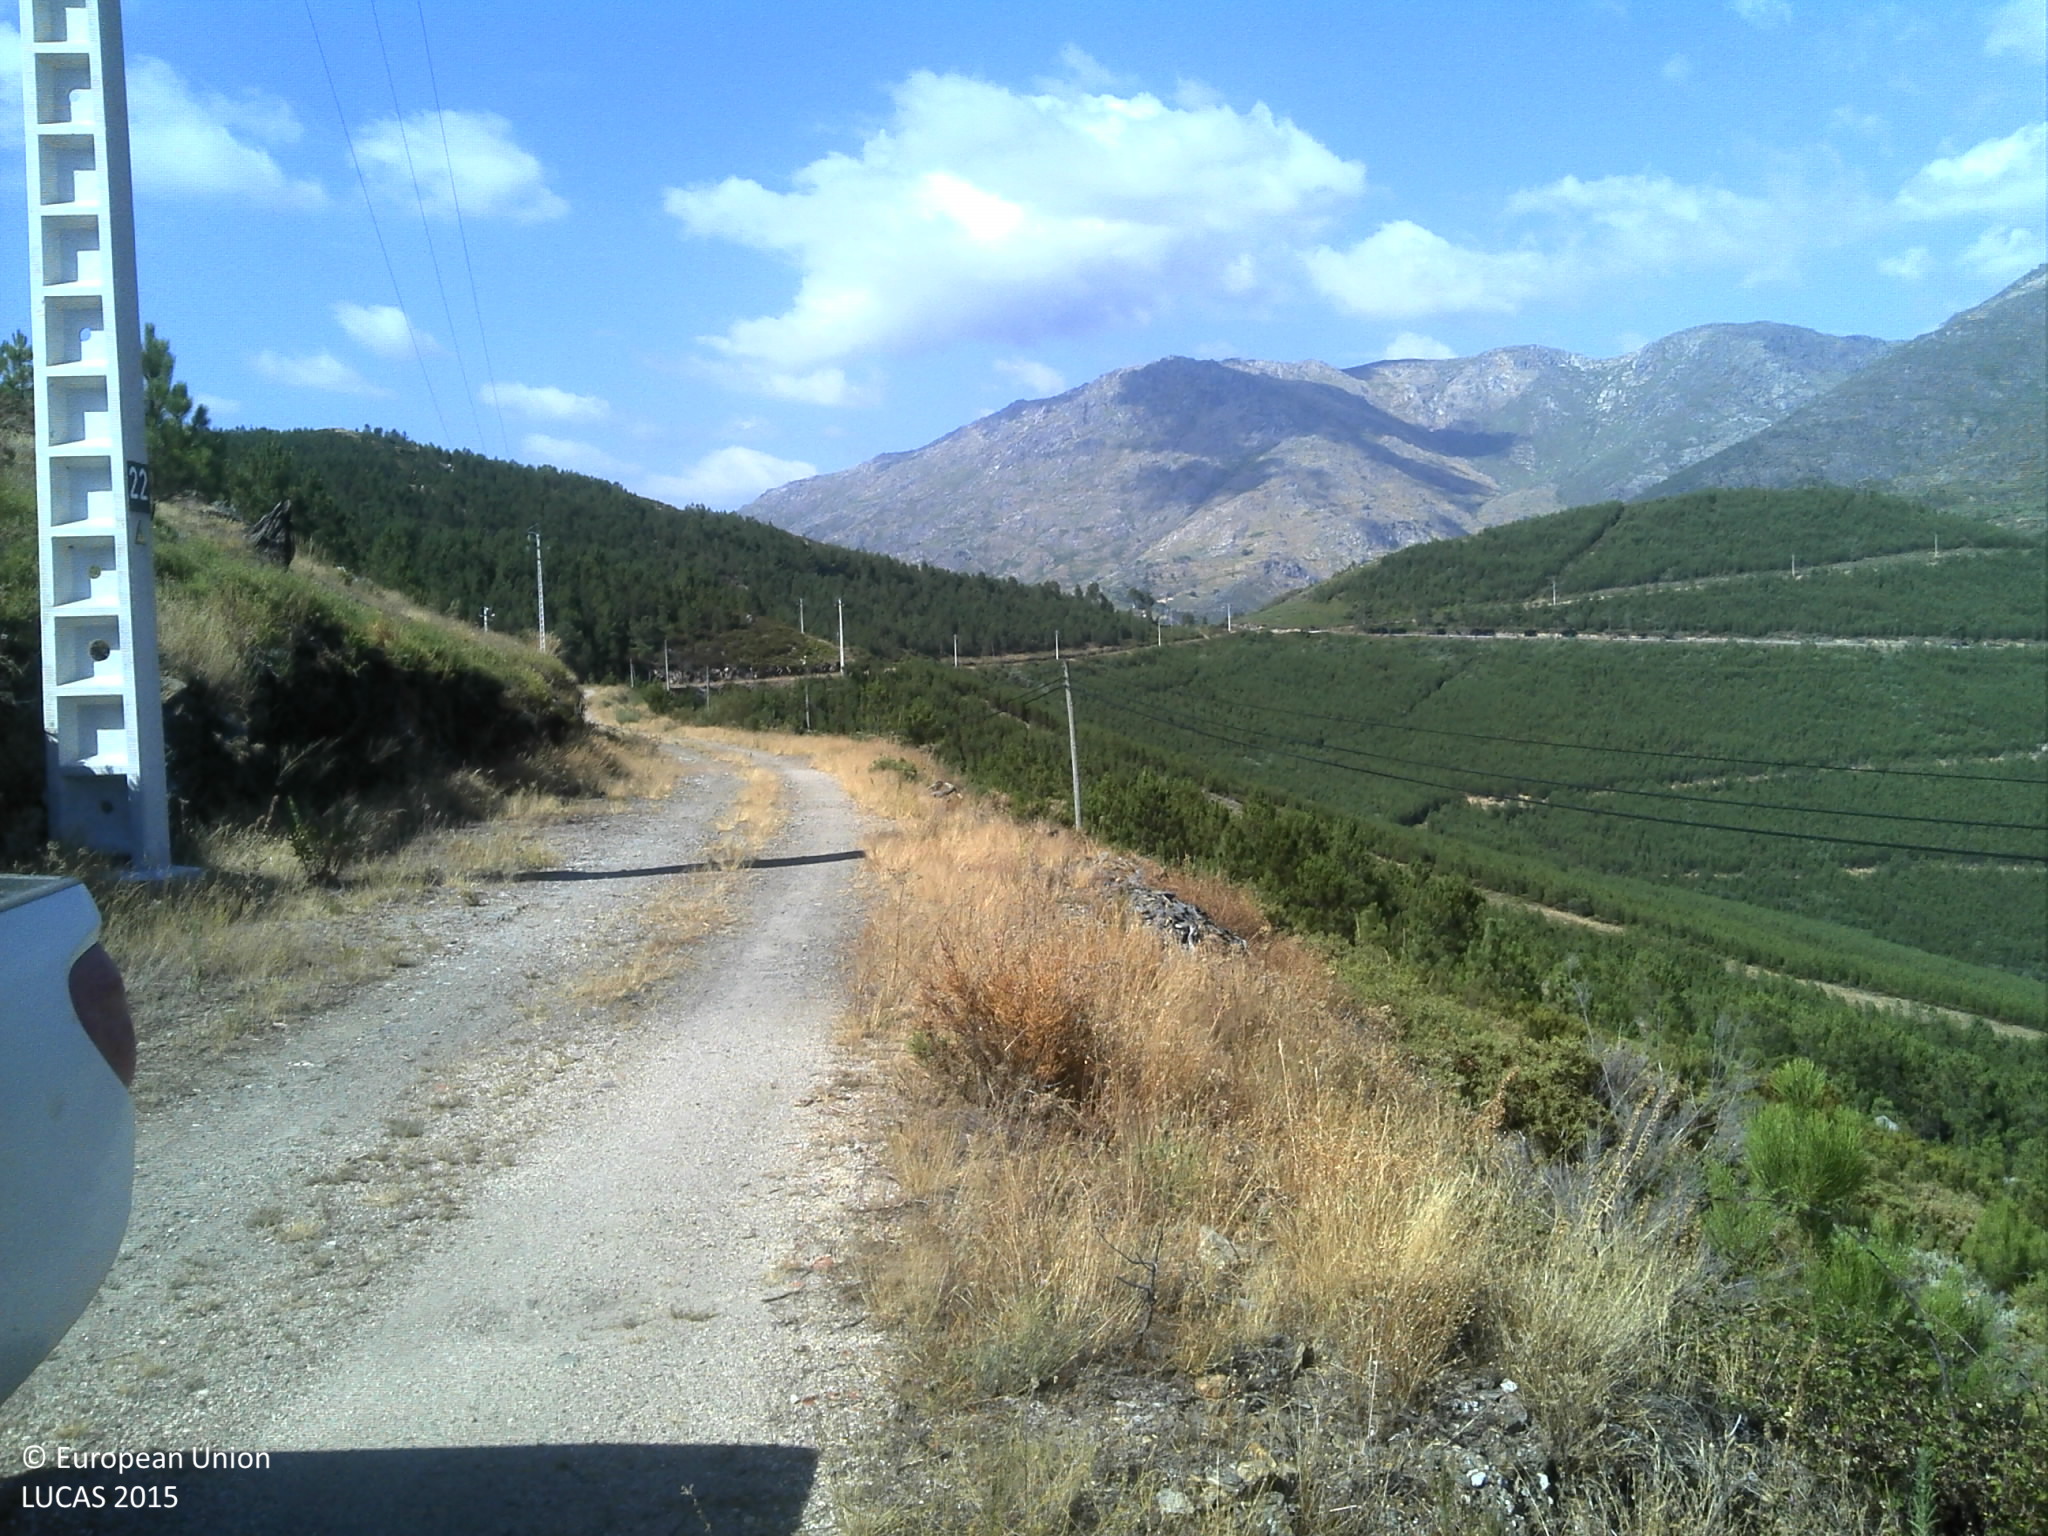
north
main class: Shrubland
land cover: Shrubland without tree cover
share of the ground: > 75 %
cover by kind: shrubs 75 %, unconsolidated bare surface 25 %
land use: Semi-natural and natural areas not in use
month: July
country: PT
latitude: 40.3049
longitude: -7.7026
